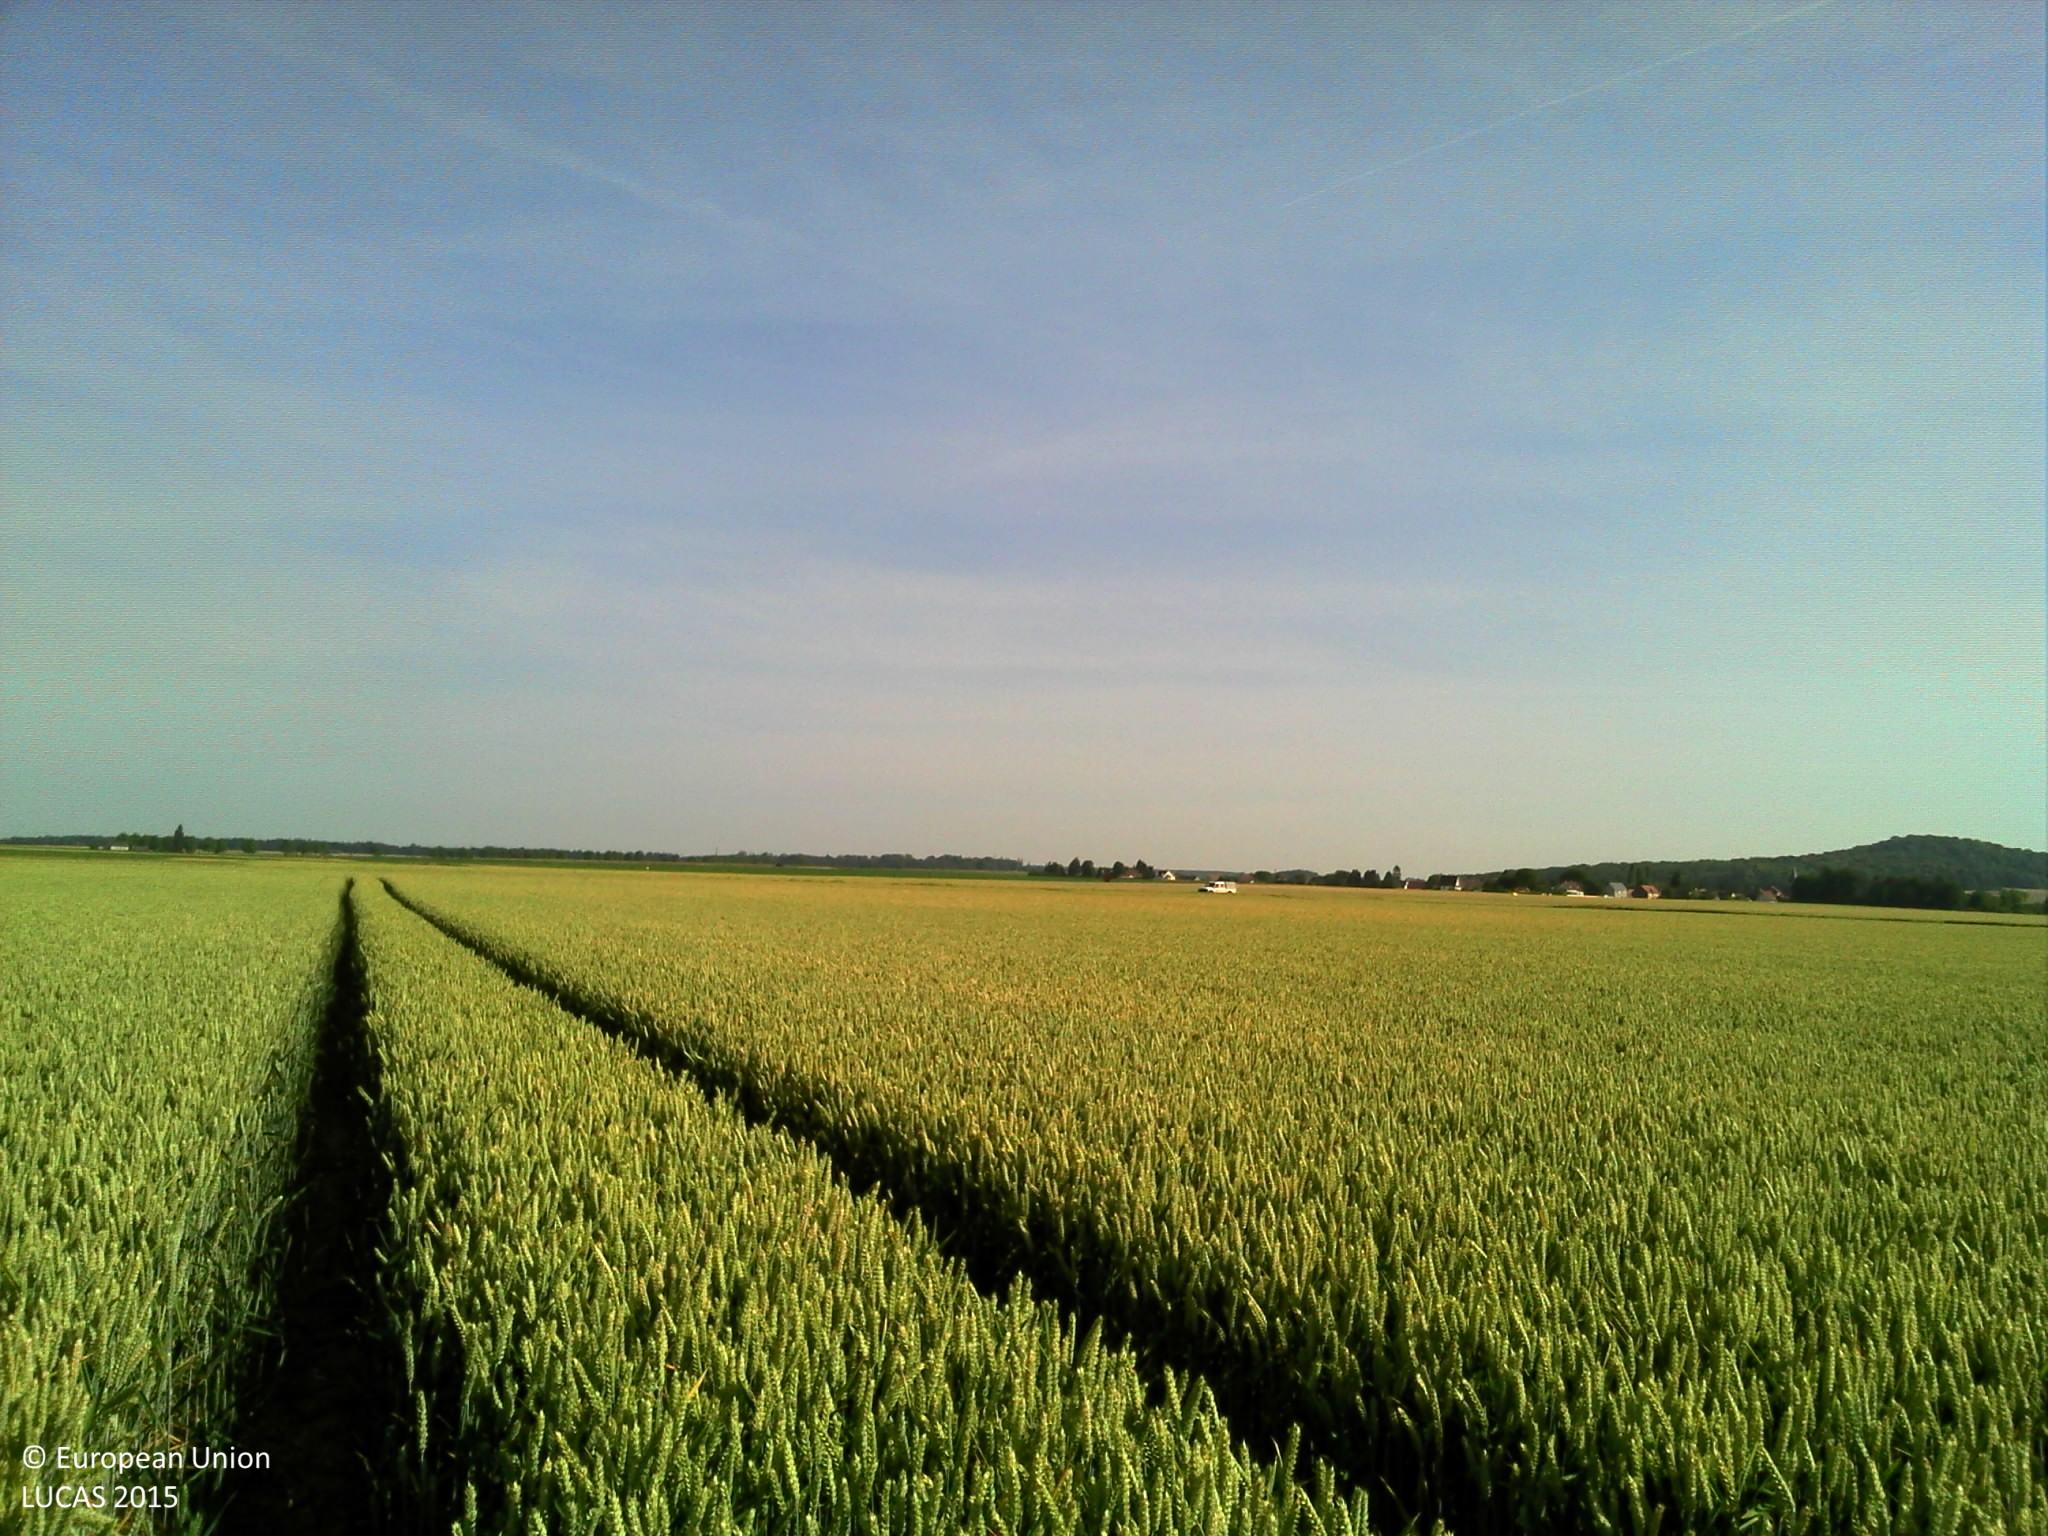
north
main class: Cropland
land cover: Common wheat
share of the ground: > 75 %
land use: Agriculture (excluding fallow land and kitchen gardens)
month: June
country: FR
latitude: 49.3492
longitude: 2.6242
